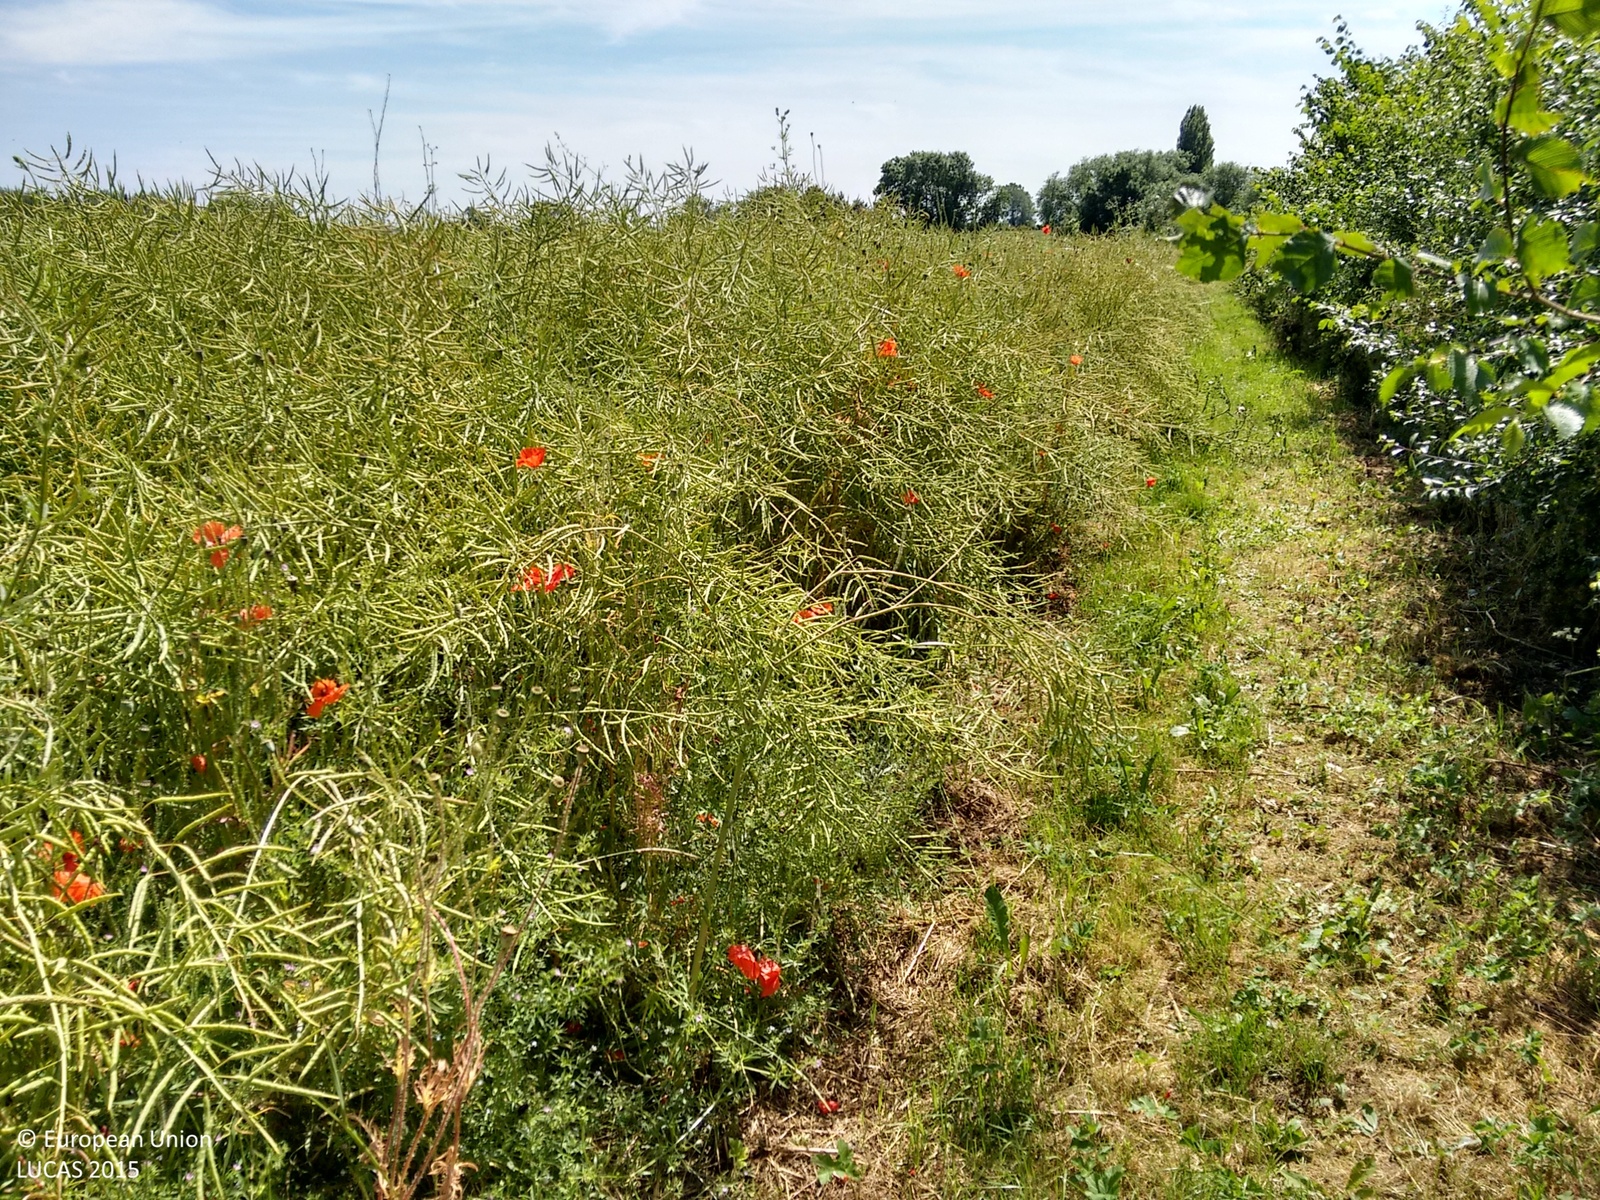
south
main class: Cropland
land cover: Rape and turnip rape
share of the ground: > 75 %
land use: Agriculture (excluding fallow land and kitchen gardens)
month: July
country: GB
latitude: 52.8991
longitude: -1.0001
